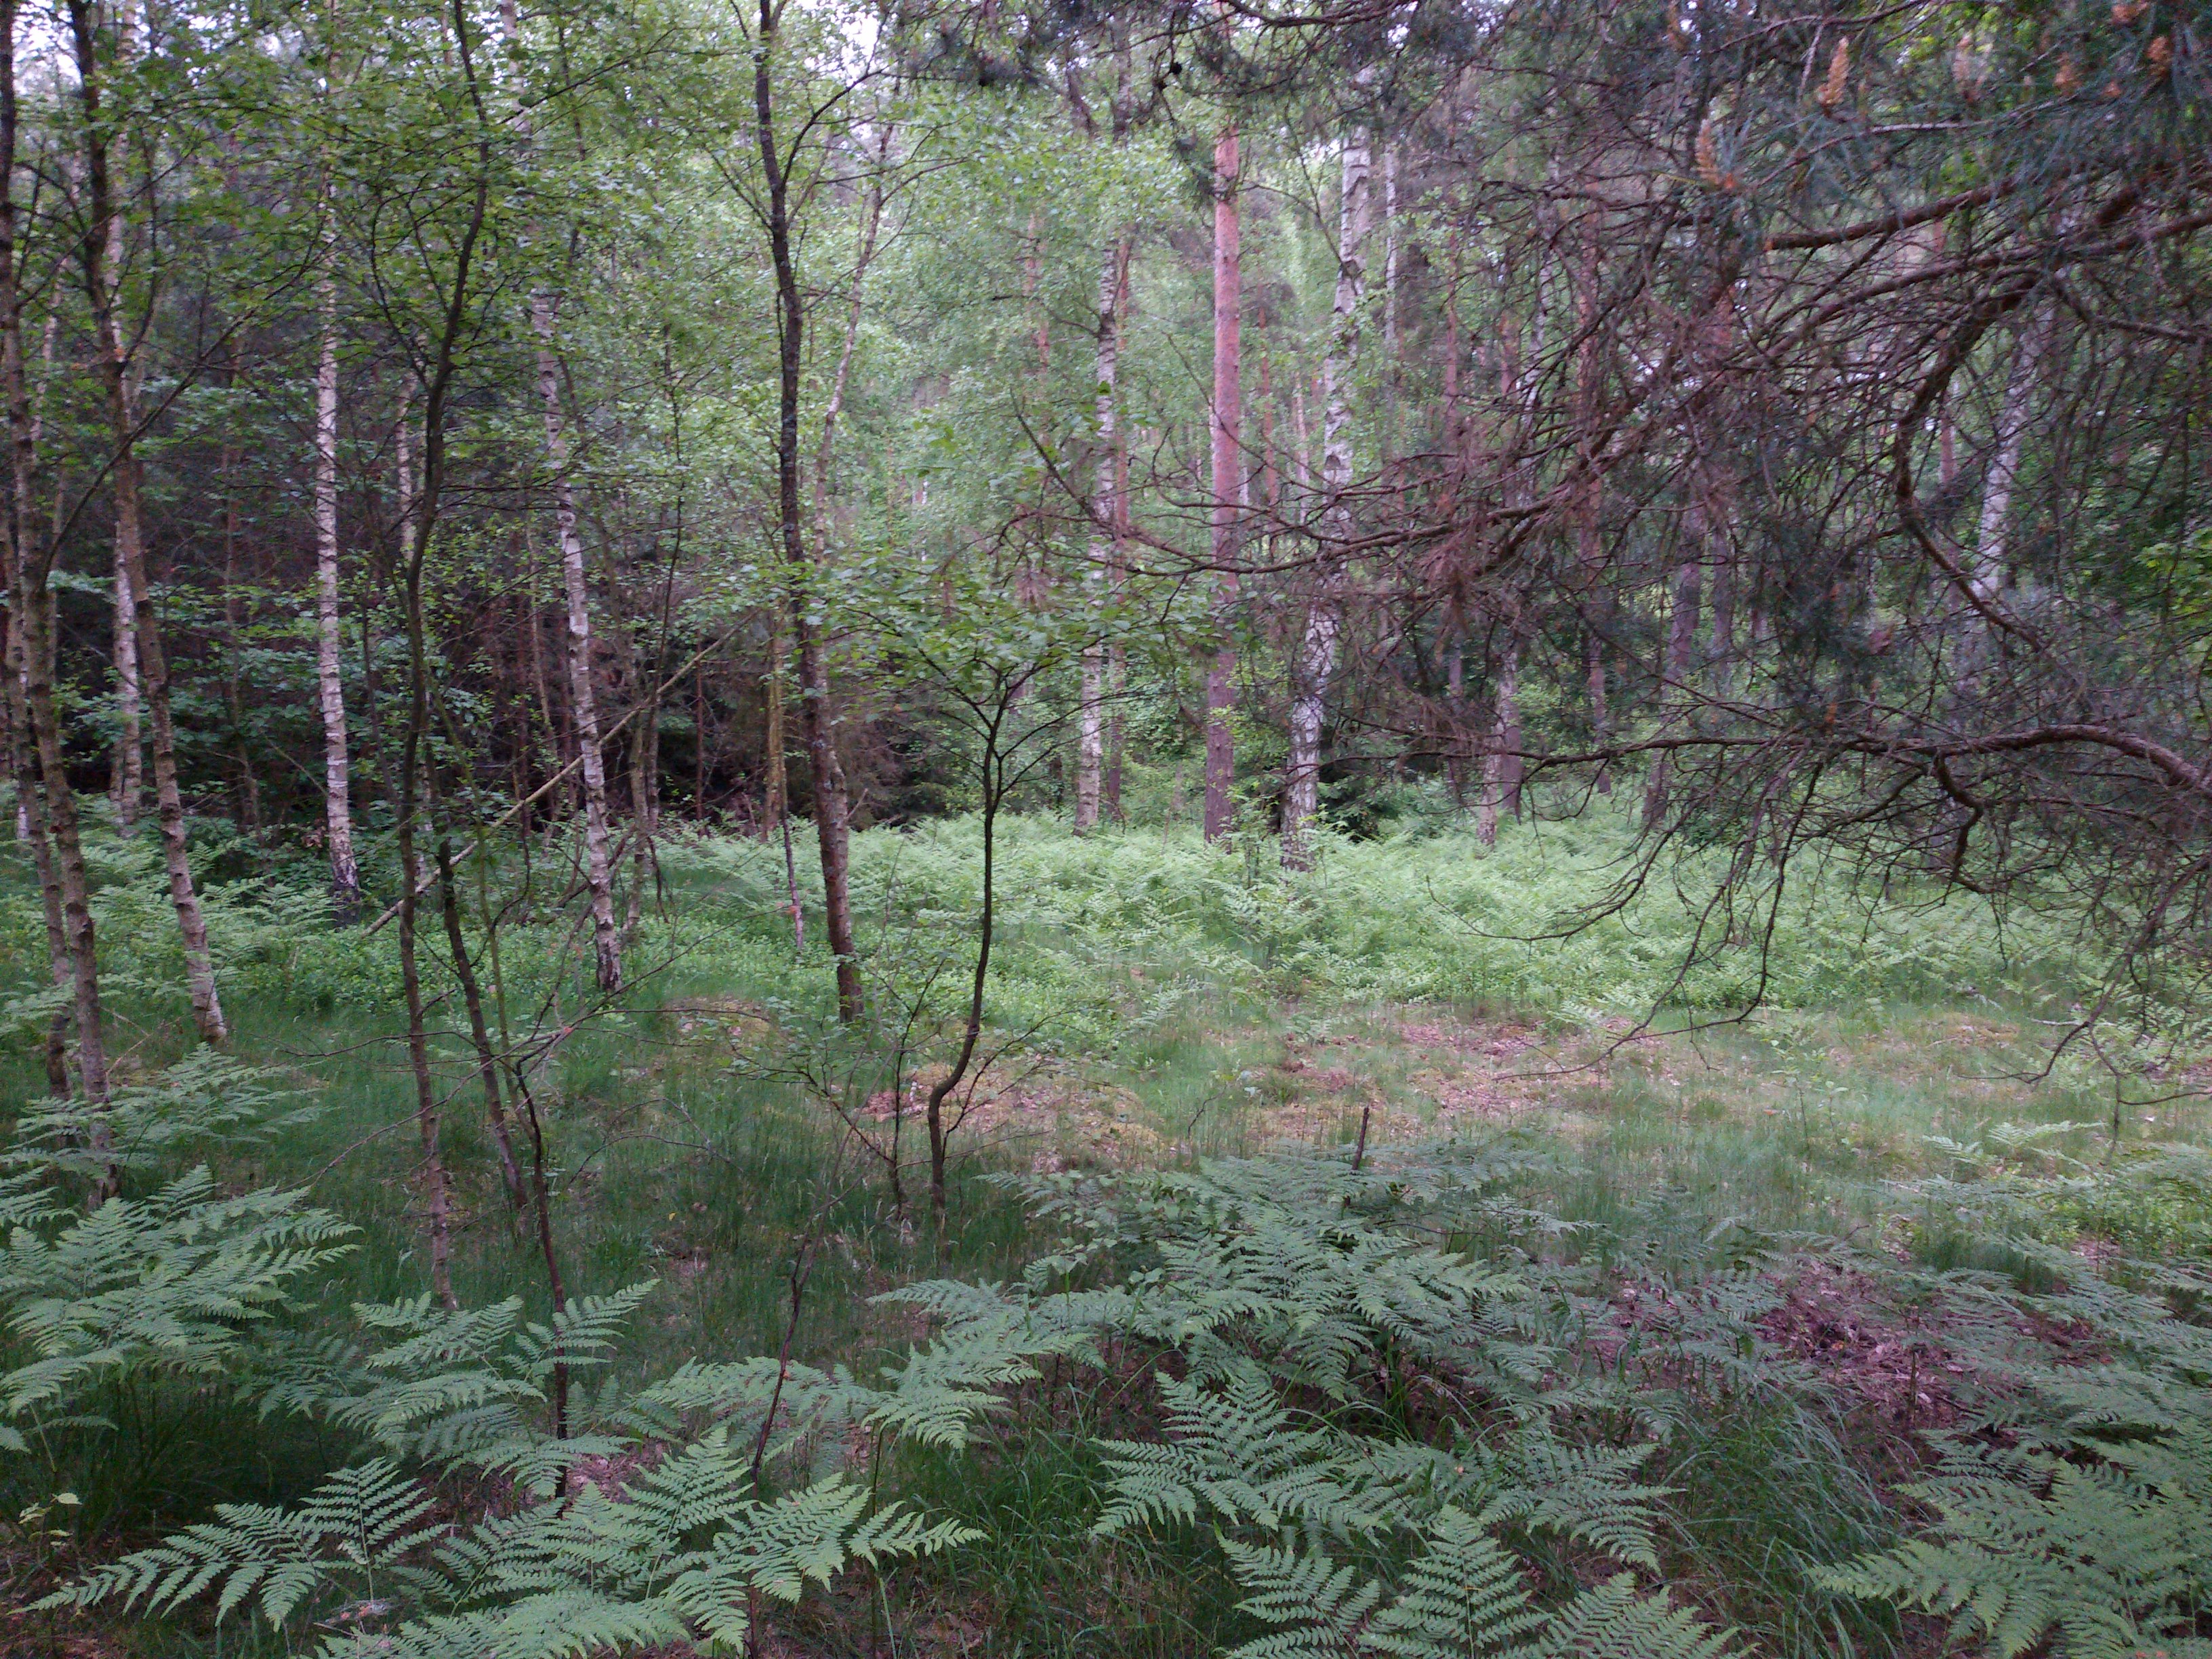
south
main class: Woodland
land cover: Pine dominated mixed woodland
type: hemiboreal forest and nemoral coniferous forest and mixed broadleaved-coniferous forest
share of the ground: 50 - 75 %
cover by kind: coniferous forest trees 50 %, broadleaved forest trees 25 %, shrubs 15 %, herbaceous plants 10 %
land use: Forestry
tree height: > 5 m
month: May
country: PL
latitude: 53.2269
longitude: 14.5400
